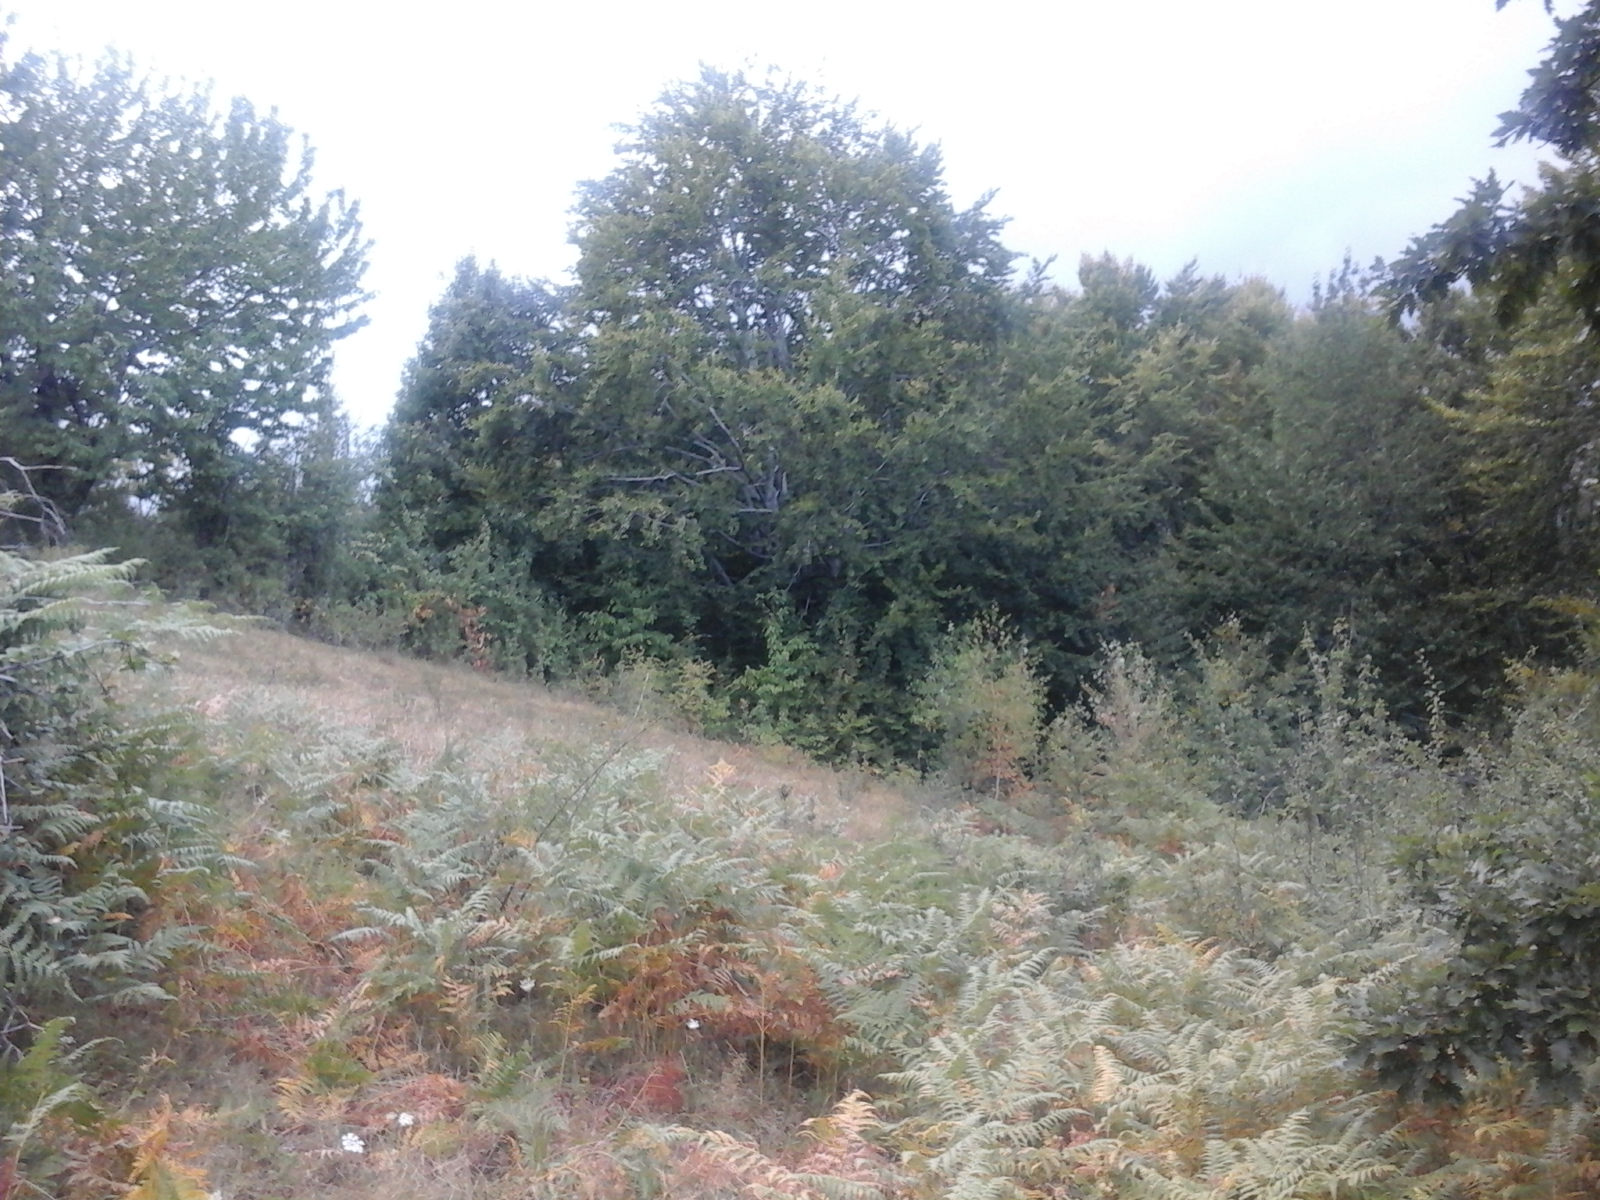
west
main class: Grassland
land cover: Grassland with sparse tree/shrub cover
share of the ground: > 75 %
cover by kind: herbaceous plants 95 %, broadleaved forest trees 5 %
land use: Agriculture (excluding fallow land and kitchen gardens)
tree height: > 5 m
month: August
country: RO
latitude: 44.9487
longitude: 22.7322
